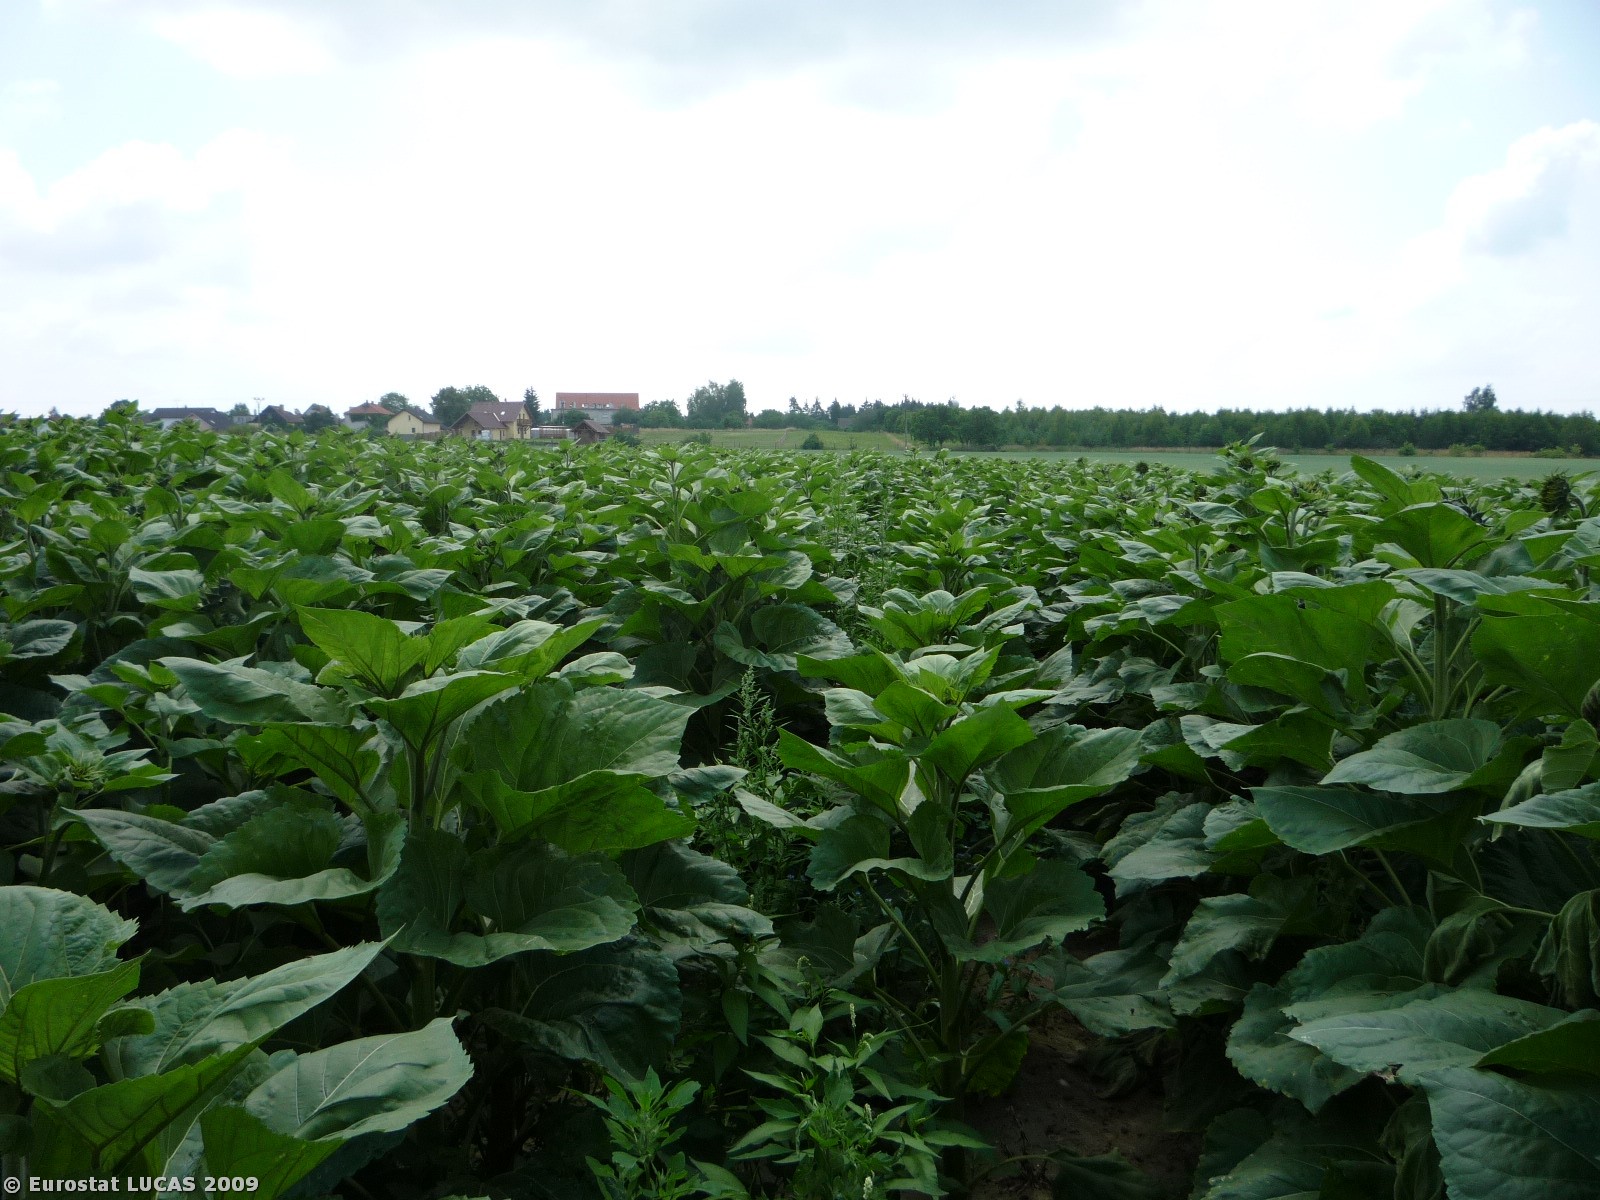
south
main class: Cropland
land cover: Sunflower
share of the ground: > 75 %
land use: Agriculture (excluding fallow land and kitchen gardens)
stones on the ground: < 10 %
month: June
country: CZ
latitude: 50.2902
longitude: 15.0137
